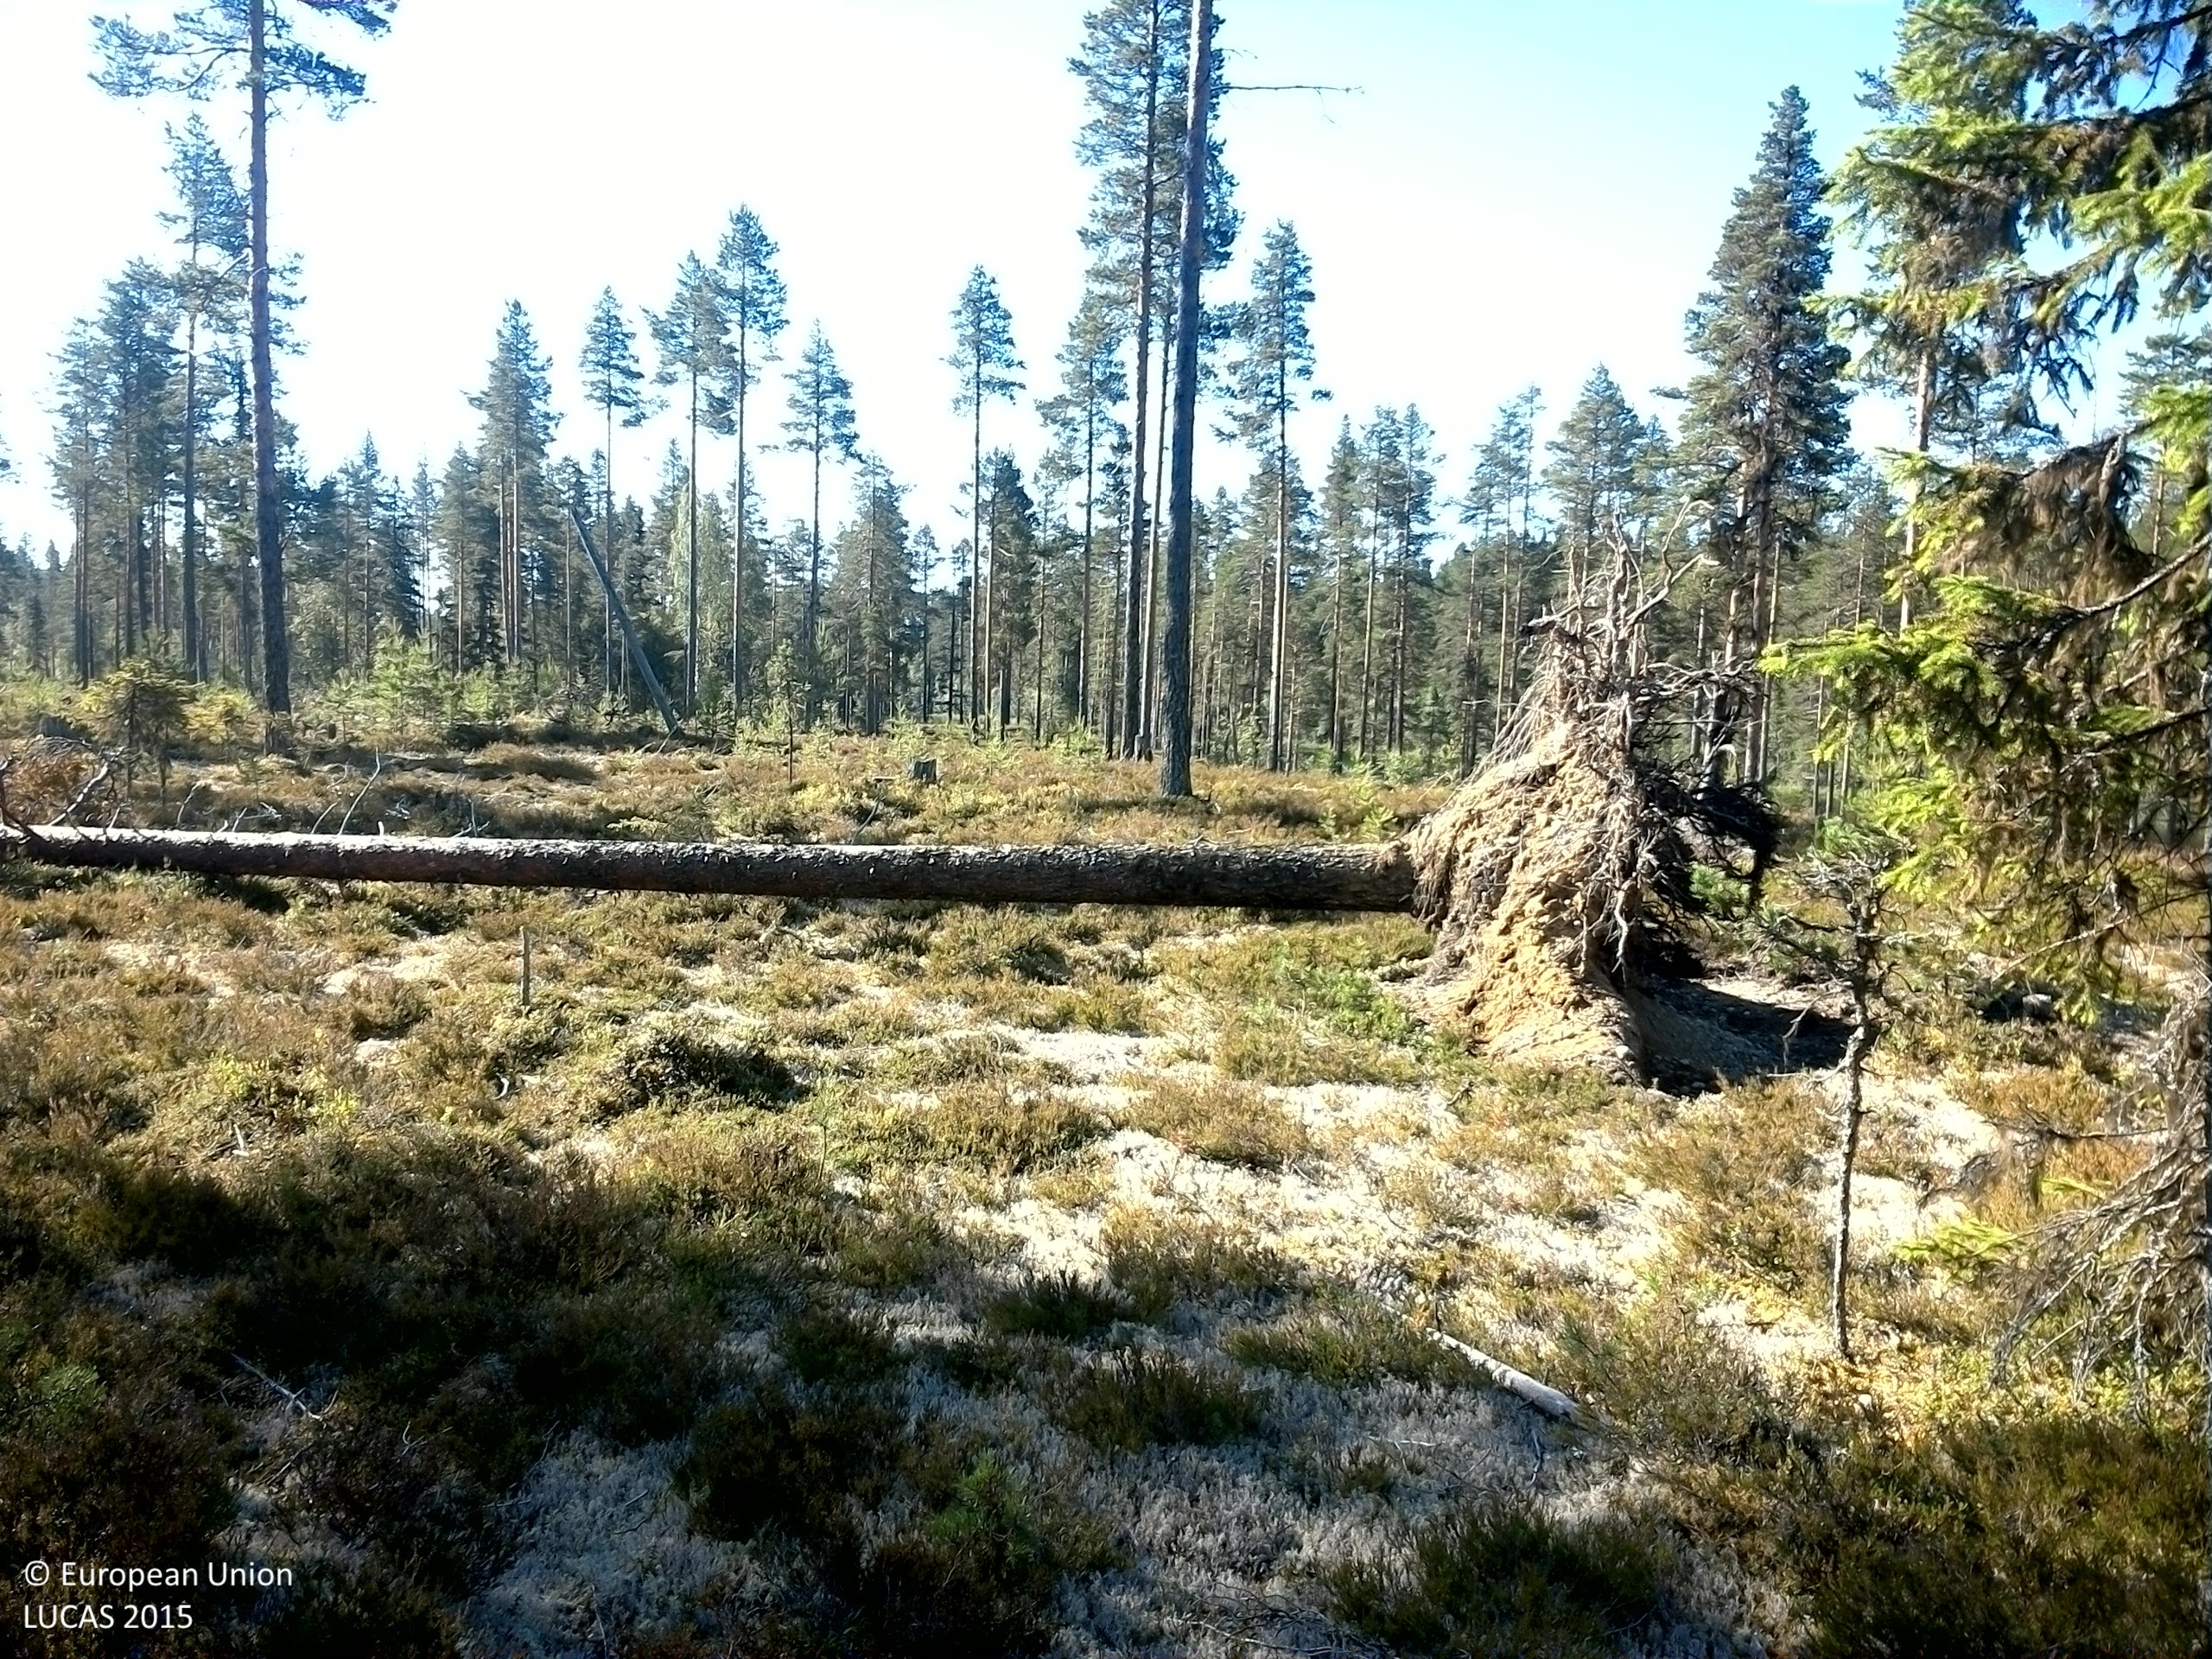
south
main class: Shrubland
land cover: Shrubland with sparse tree cover
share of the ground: 50 - 75 %
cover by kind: shrubs 60 %, lichens and mosses 35 %, coniferous forest trees 5 %
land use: Forestry
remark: Clear cut
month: August
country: SE
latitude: 63.7534
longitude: 16.5997
